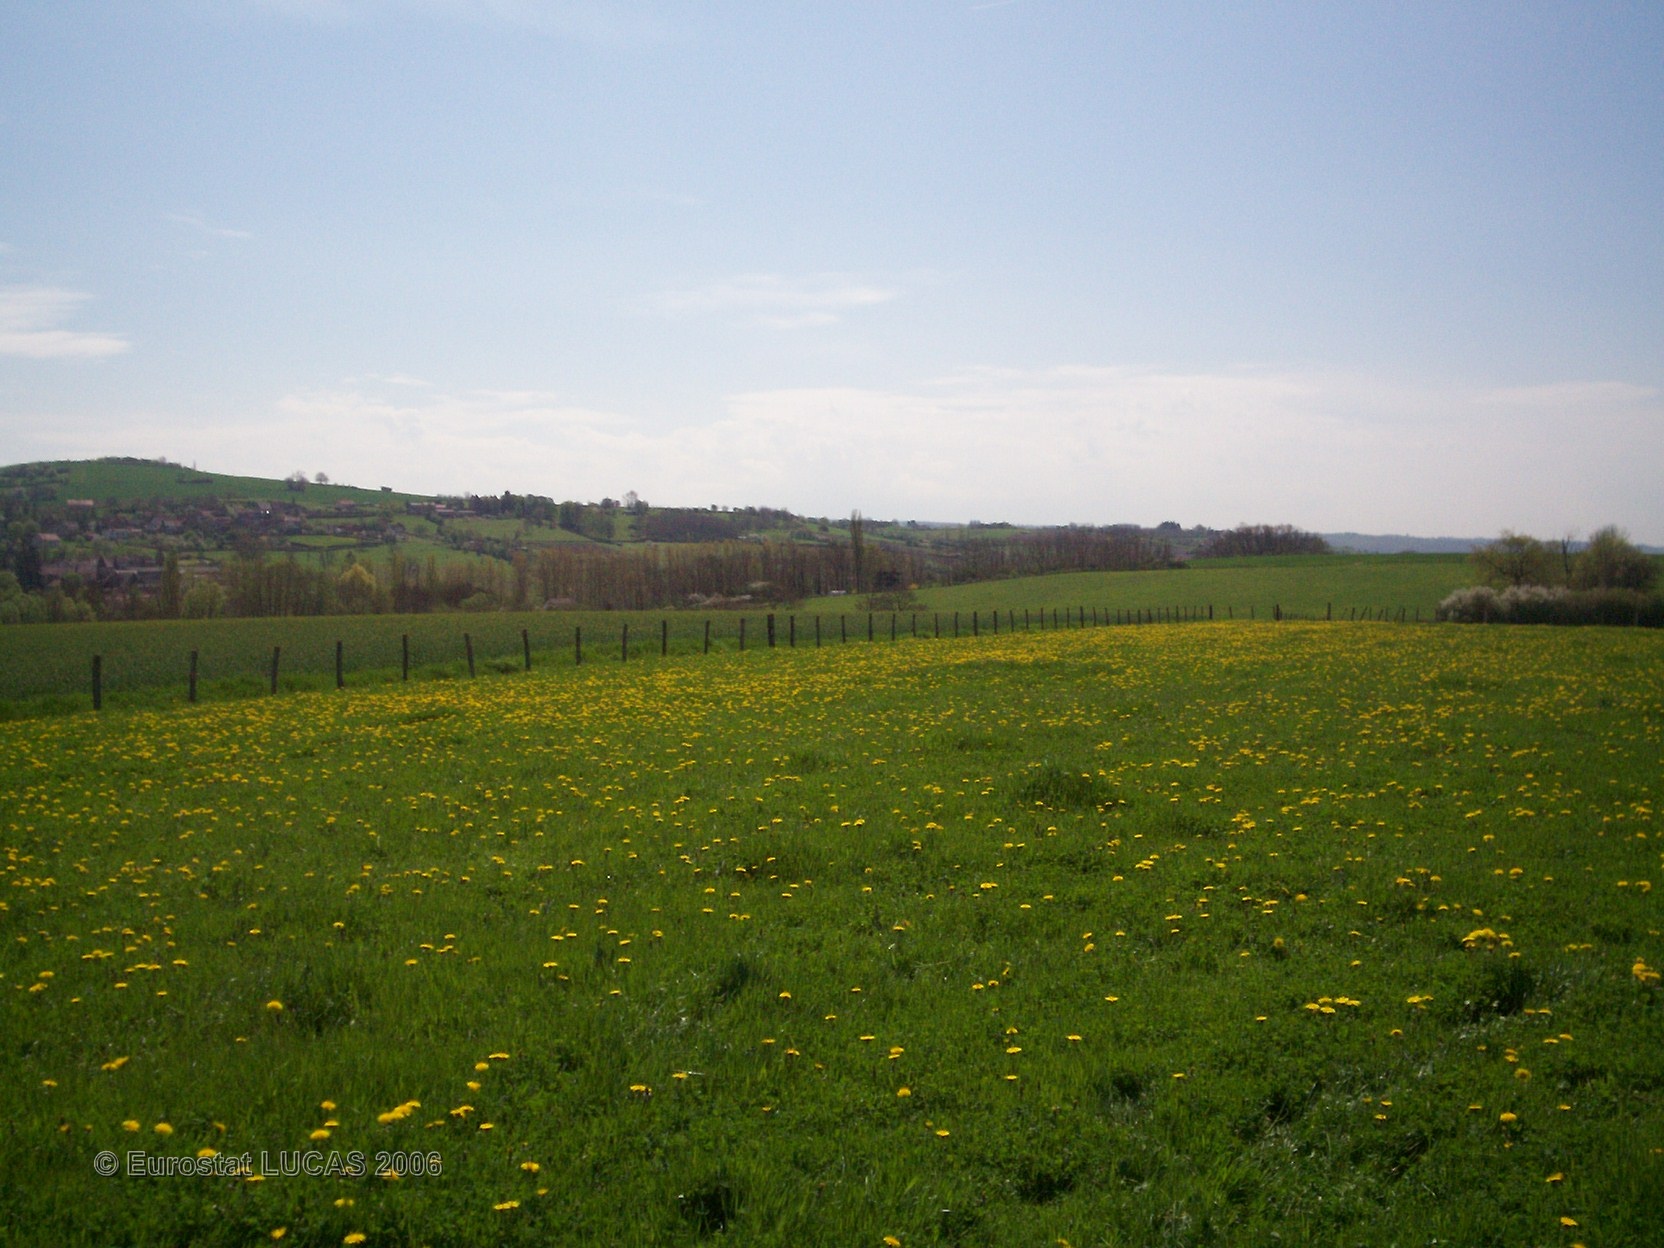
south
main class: Grassland
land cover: Grassland without tree/shrub cover
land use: Agriculture (excluding fallow land and kitchen gardens)
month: April
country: FR
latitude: 46.8856
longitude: 4.6596
